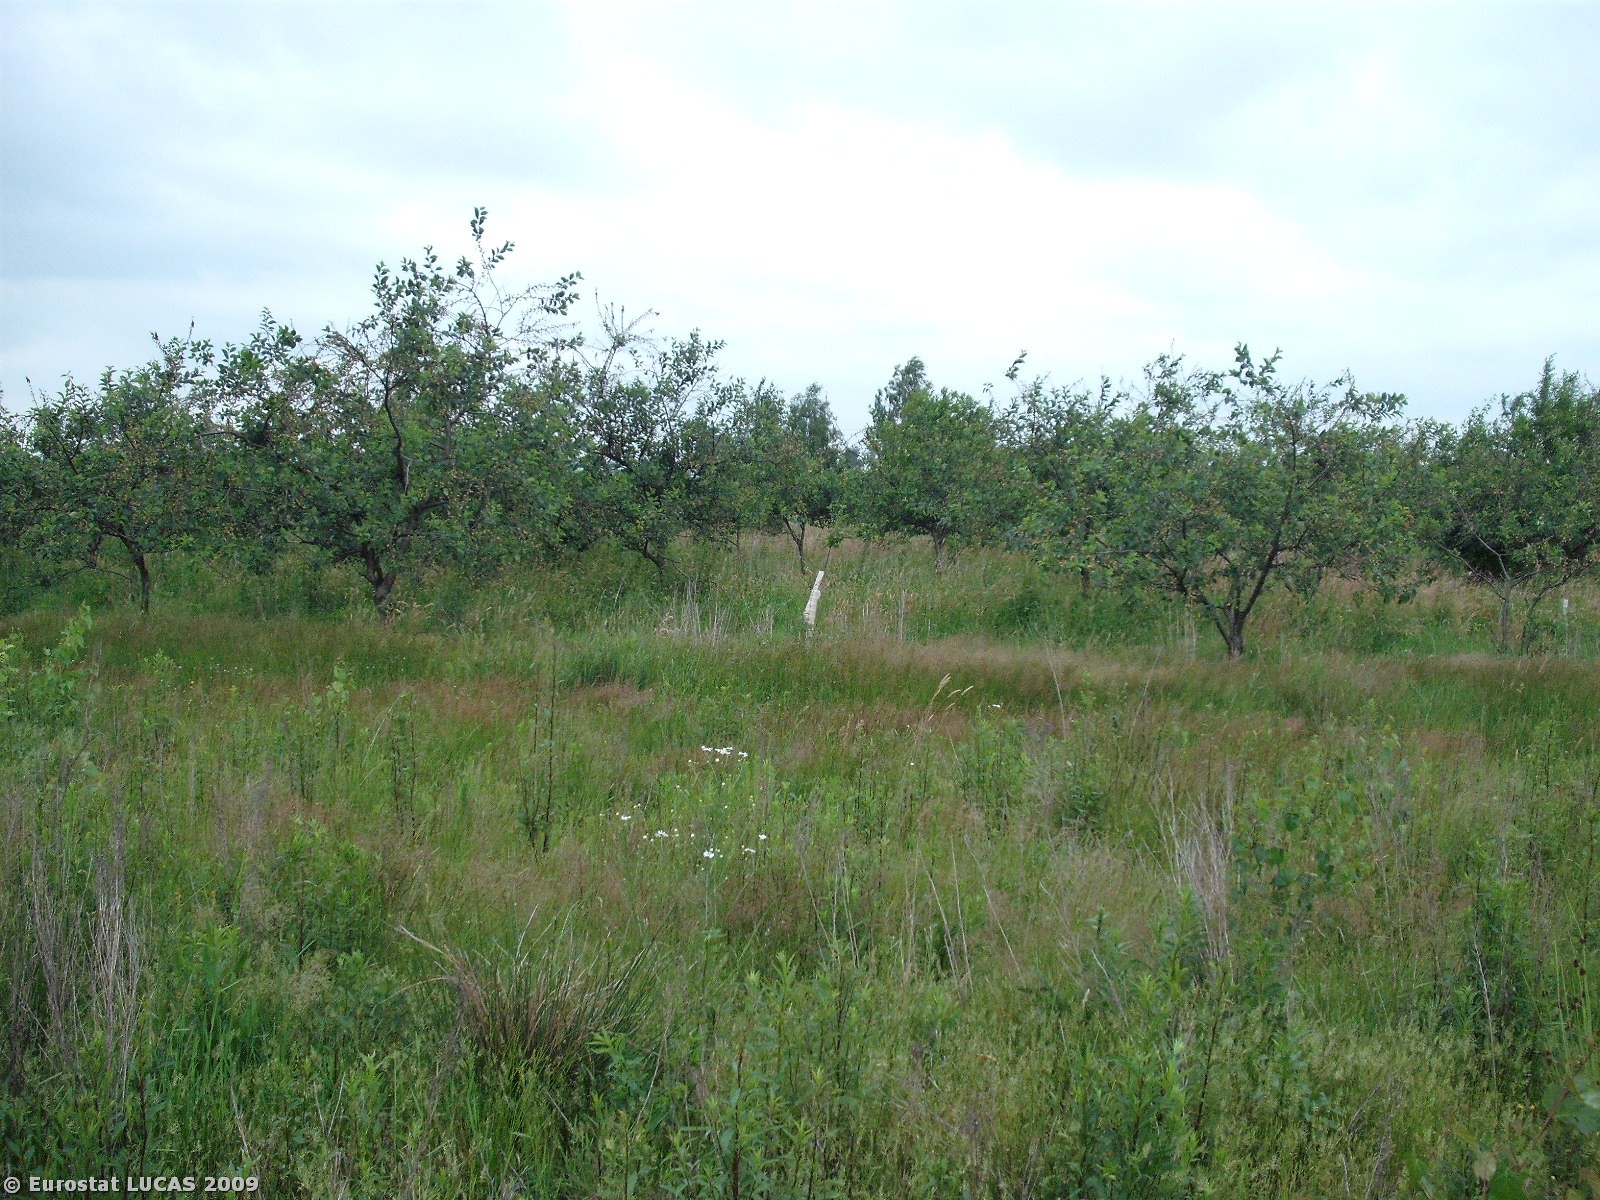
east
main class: Grassland
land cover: Grassland with sparse tree/shrub cover
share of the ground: 50 - 75 %
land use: Fallow land
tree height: < 5 m
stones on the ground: < 10 %
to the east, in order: Grassland with sparse tree/shrub cover; Cherry fruit; Grassland with sparse tree/shrub cover; Grassland without tree/shrub cover; Triticale; Other fruit trees and berries; Triticale; Spontaneously vegetated surfaces; Electric lines; Spontaneously vegetated surfaces; Broadleaved woodland; Triticale
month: June
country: PL
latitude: 51.3756
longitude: 20.5988
